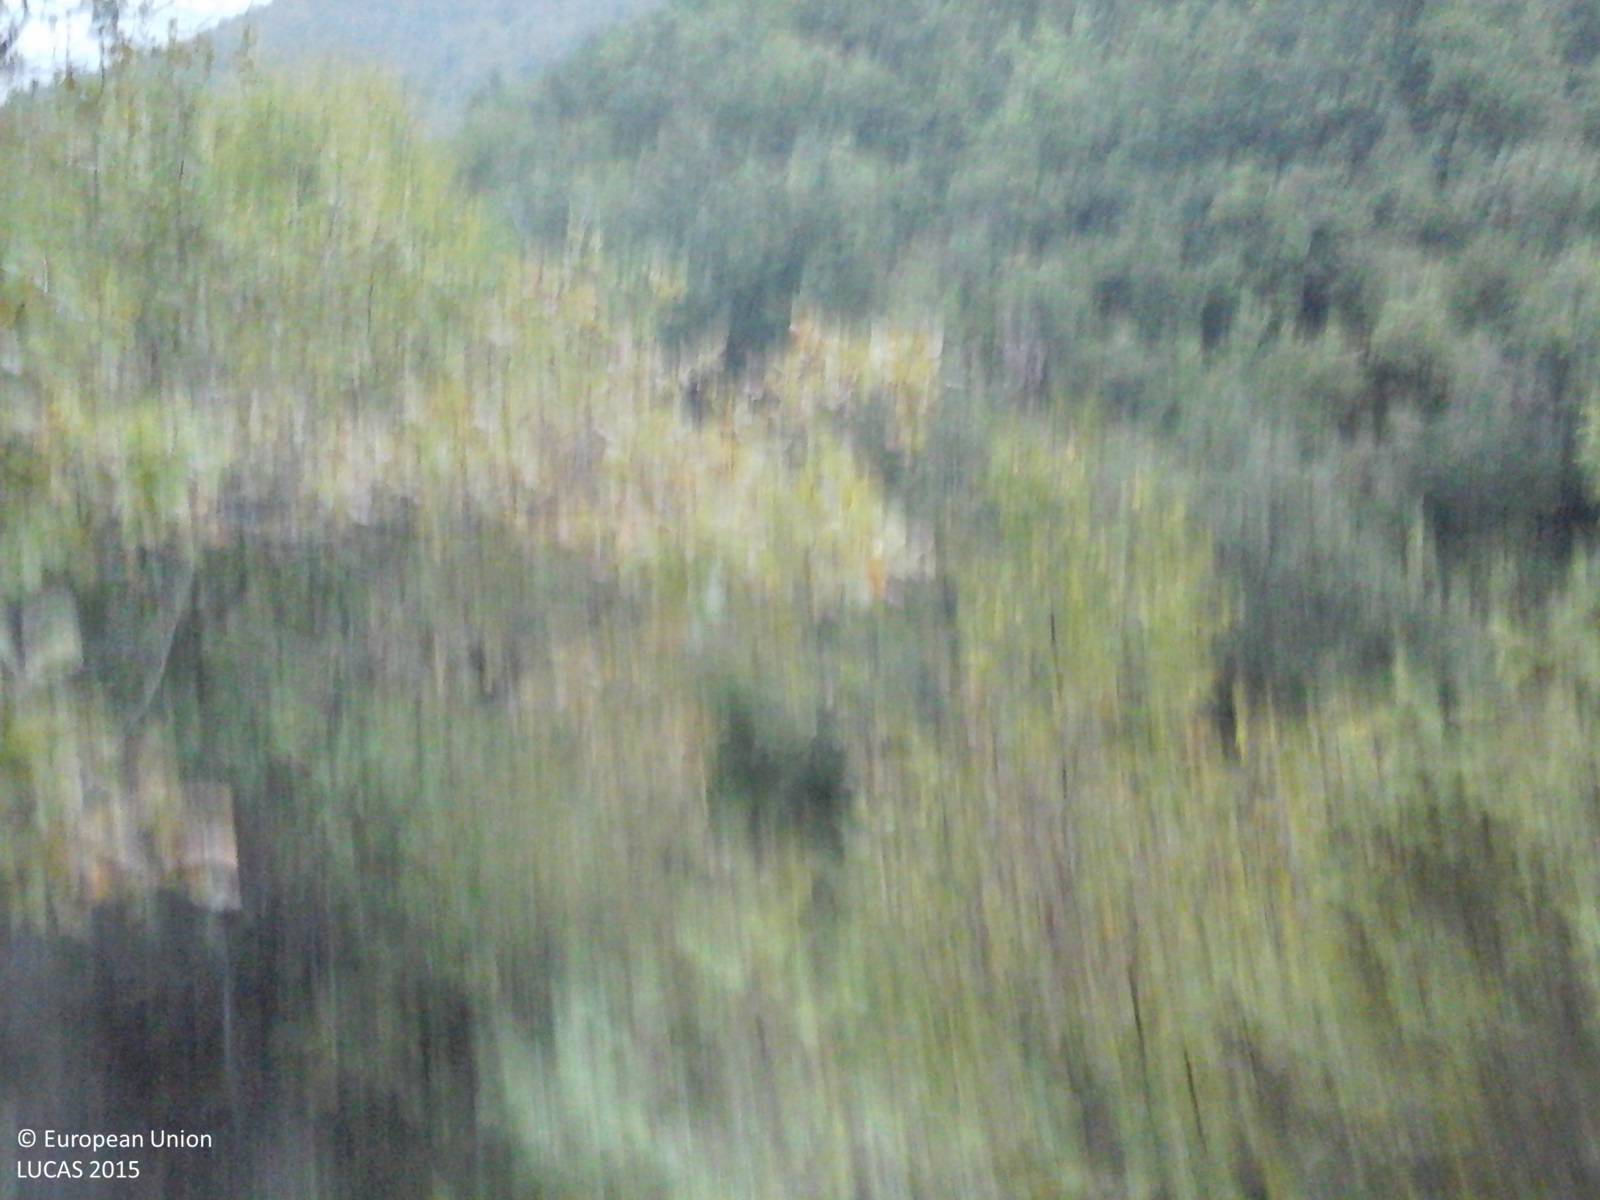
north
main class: Woodland
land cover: Broadleaved woodland
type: thermophilous deciduous forest
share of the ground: > 75 %
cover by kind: broadleaved forest trees 100 %
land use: Semi-natural and natural areas not in use
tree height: > 5 m
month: October
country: IT
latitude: 42.4450
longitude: 13.0660
